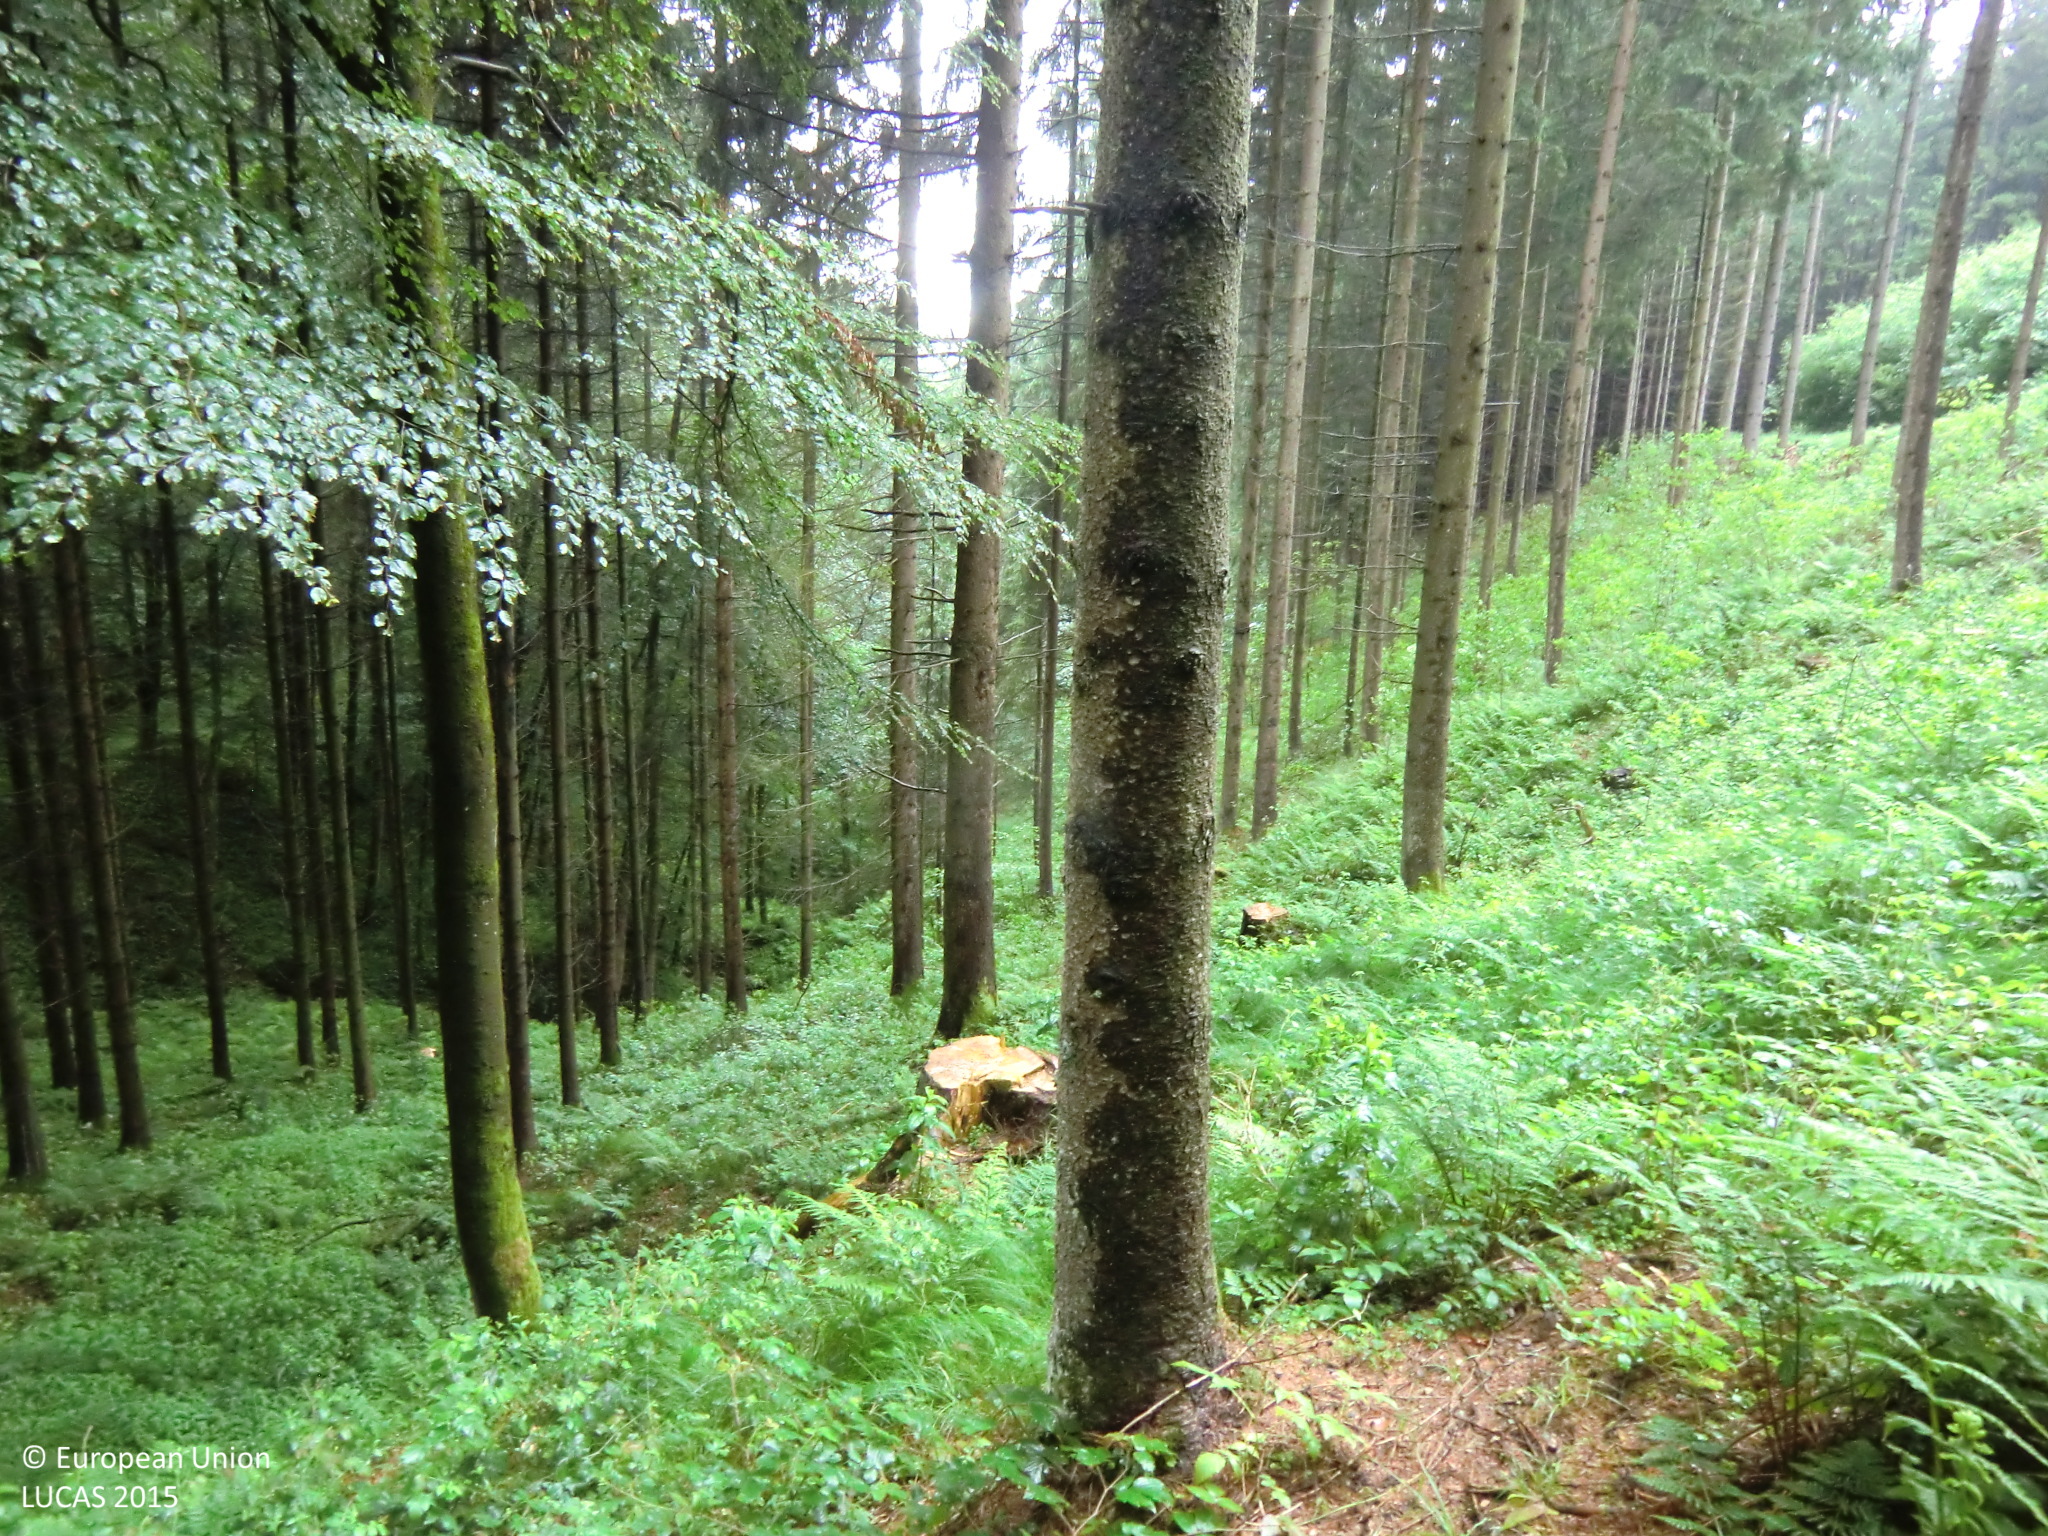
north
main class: Woodland
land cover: Spruce dominated coniferous woodland
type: hemiboreal forest and nemoral coniferous forest and mixed broadleaved-coniferous forest
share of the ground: 50 - 75 %
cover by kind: coniferous forest trees 70 %, herbaceous plants 20 %, lichens and mosses 5 %, unconsolidated bare surface 5 %
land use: Forestry
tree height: > 5 m
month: June
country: AT
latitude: 48.3045
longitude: 14.6790
